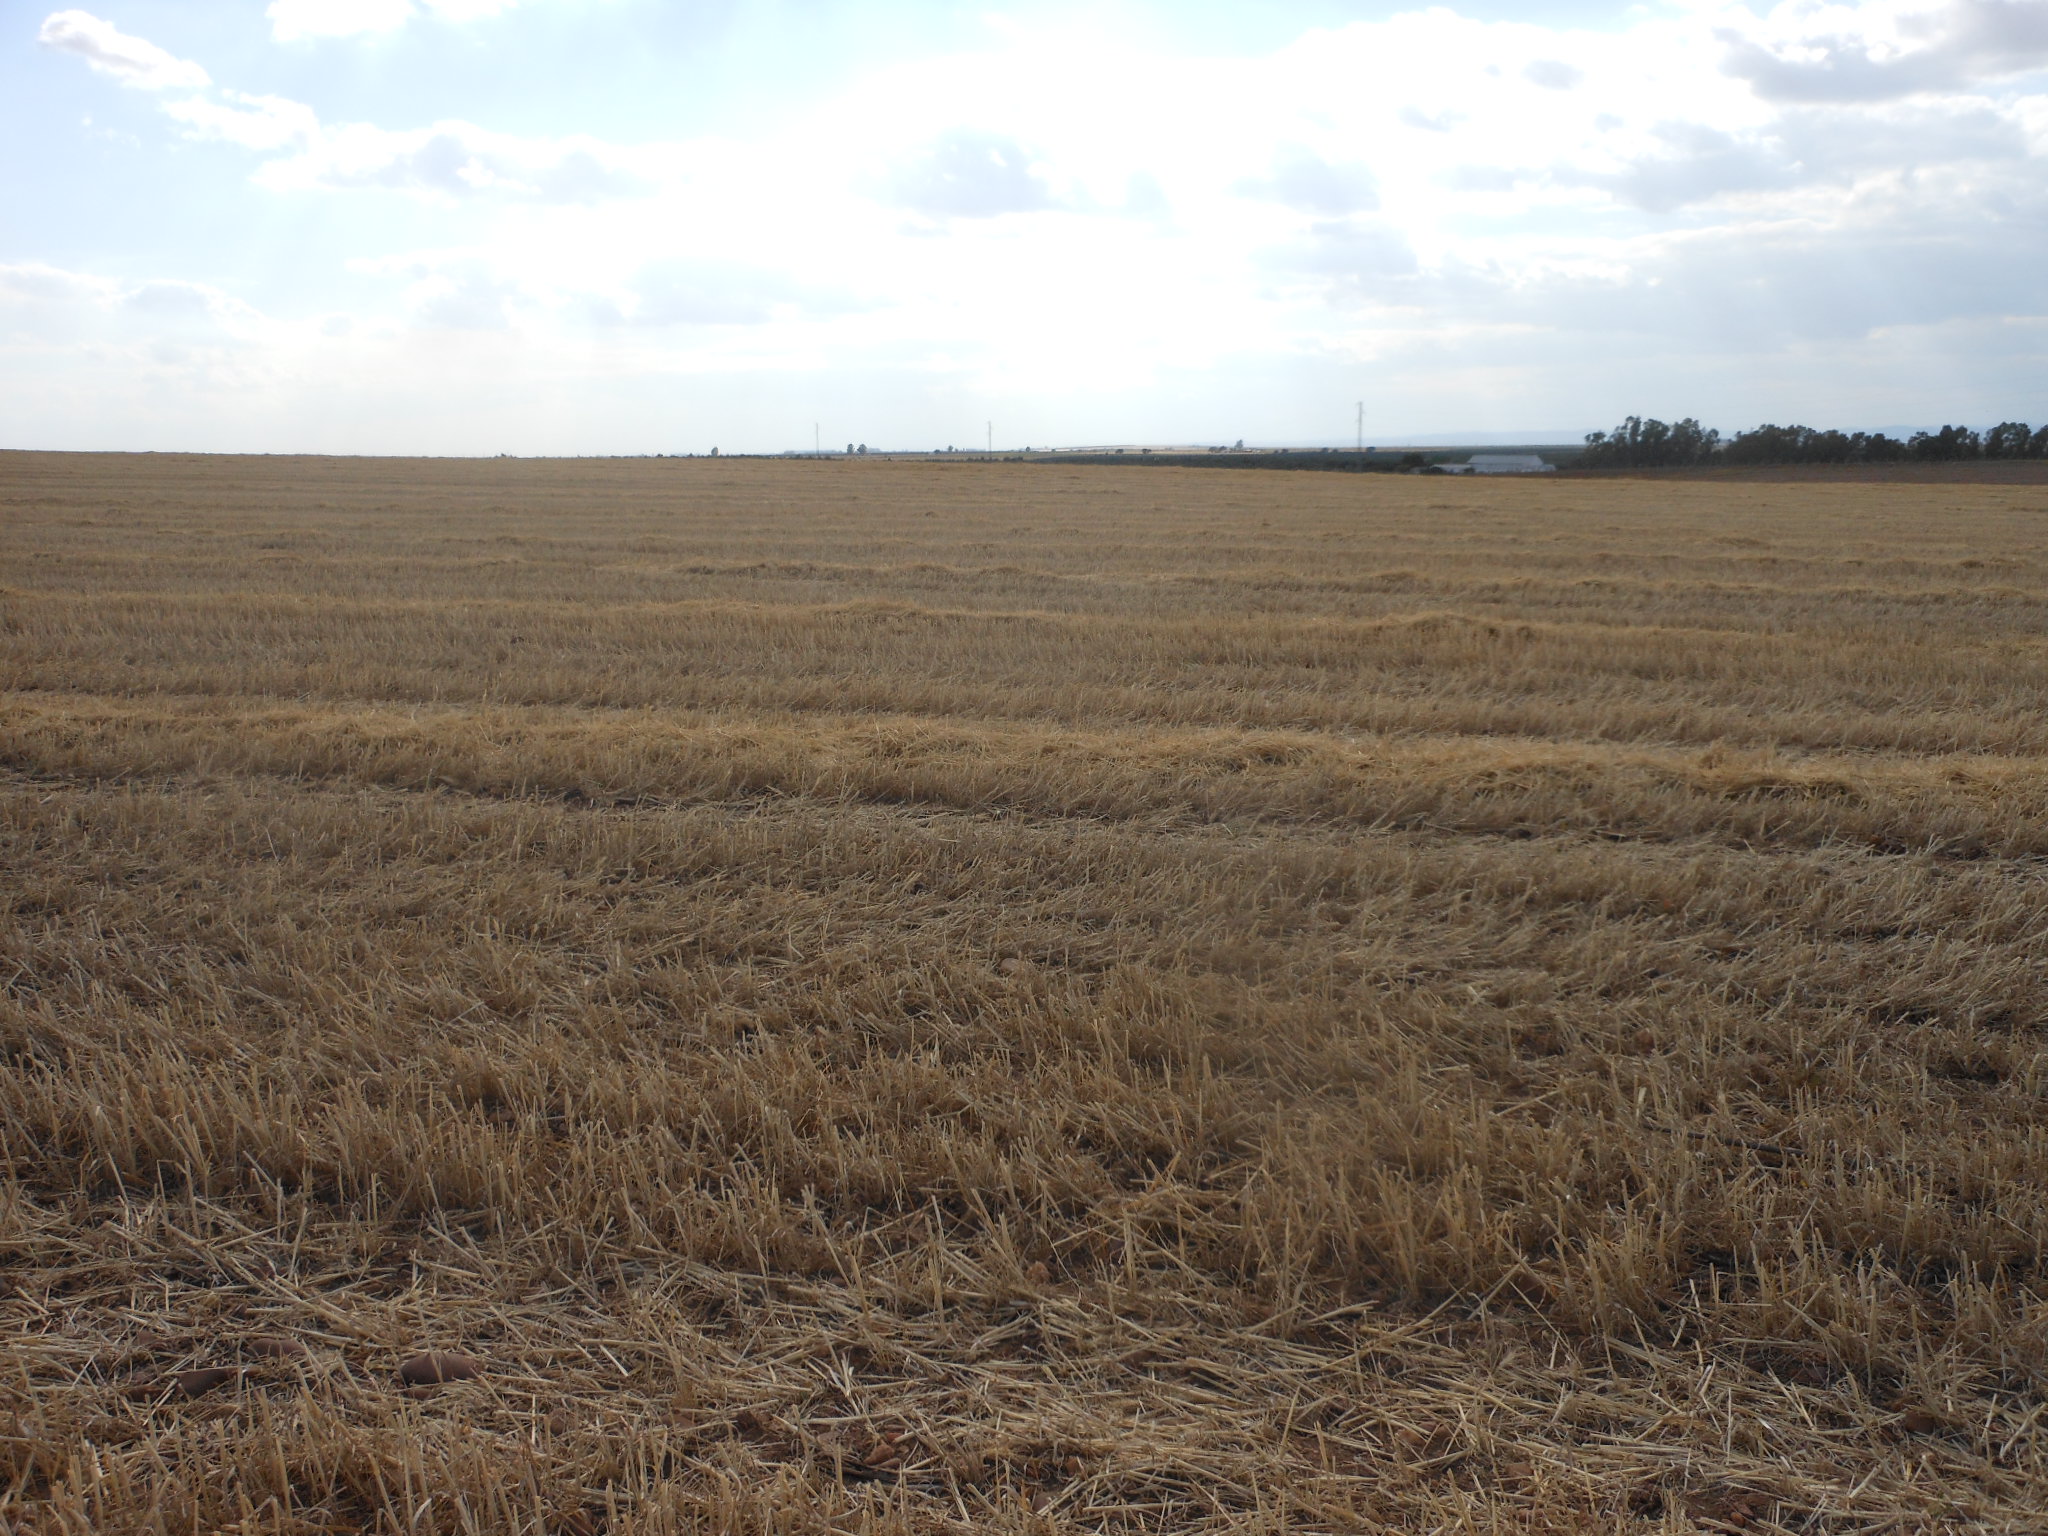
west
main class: Cropland
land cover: Durum wheat
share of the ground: < 10 %
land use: Agriculture (excluding fallow land and kitchen gardens)
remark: Harvested field
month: June
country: ES
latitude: 37.6210
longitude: -5.2092
